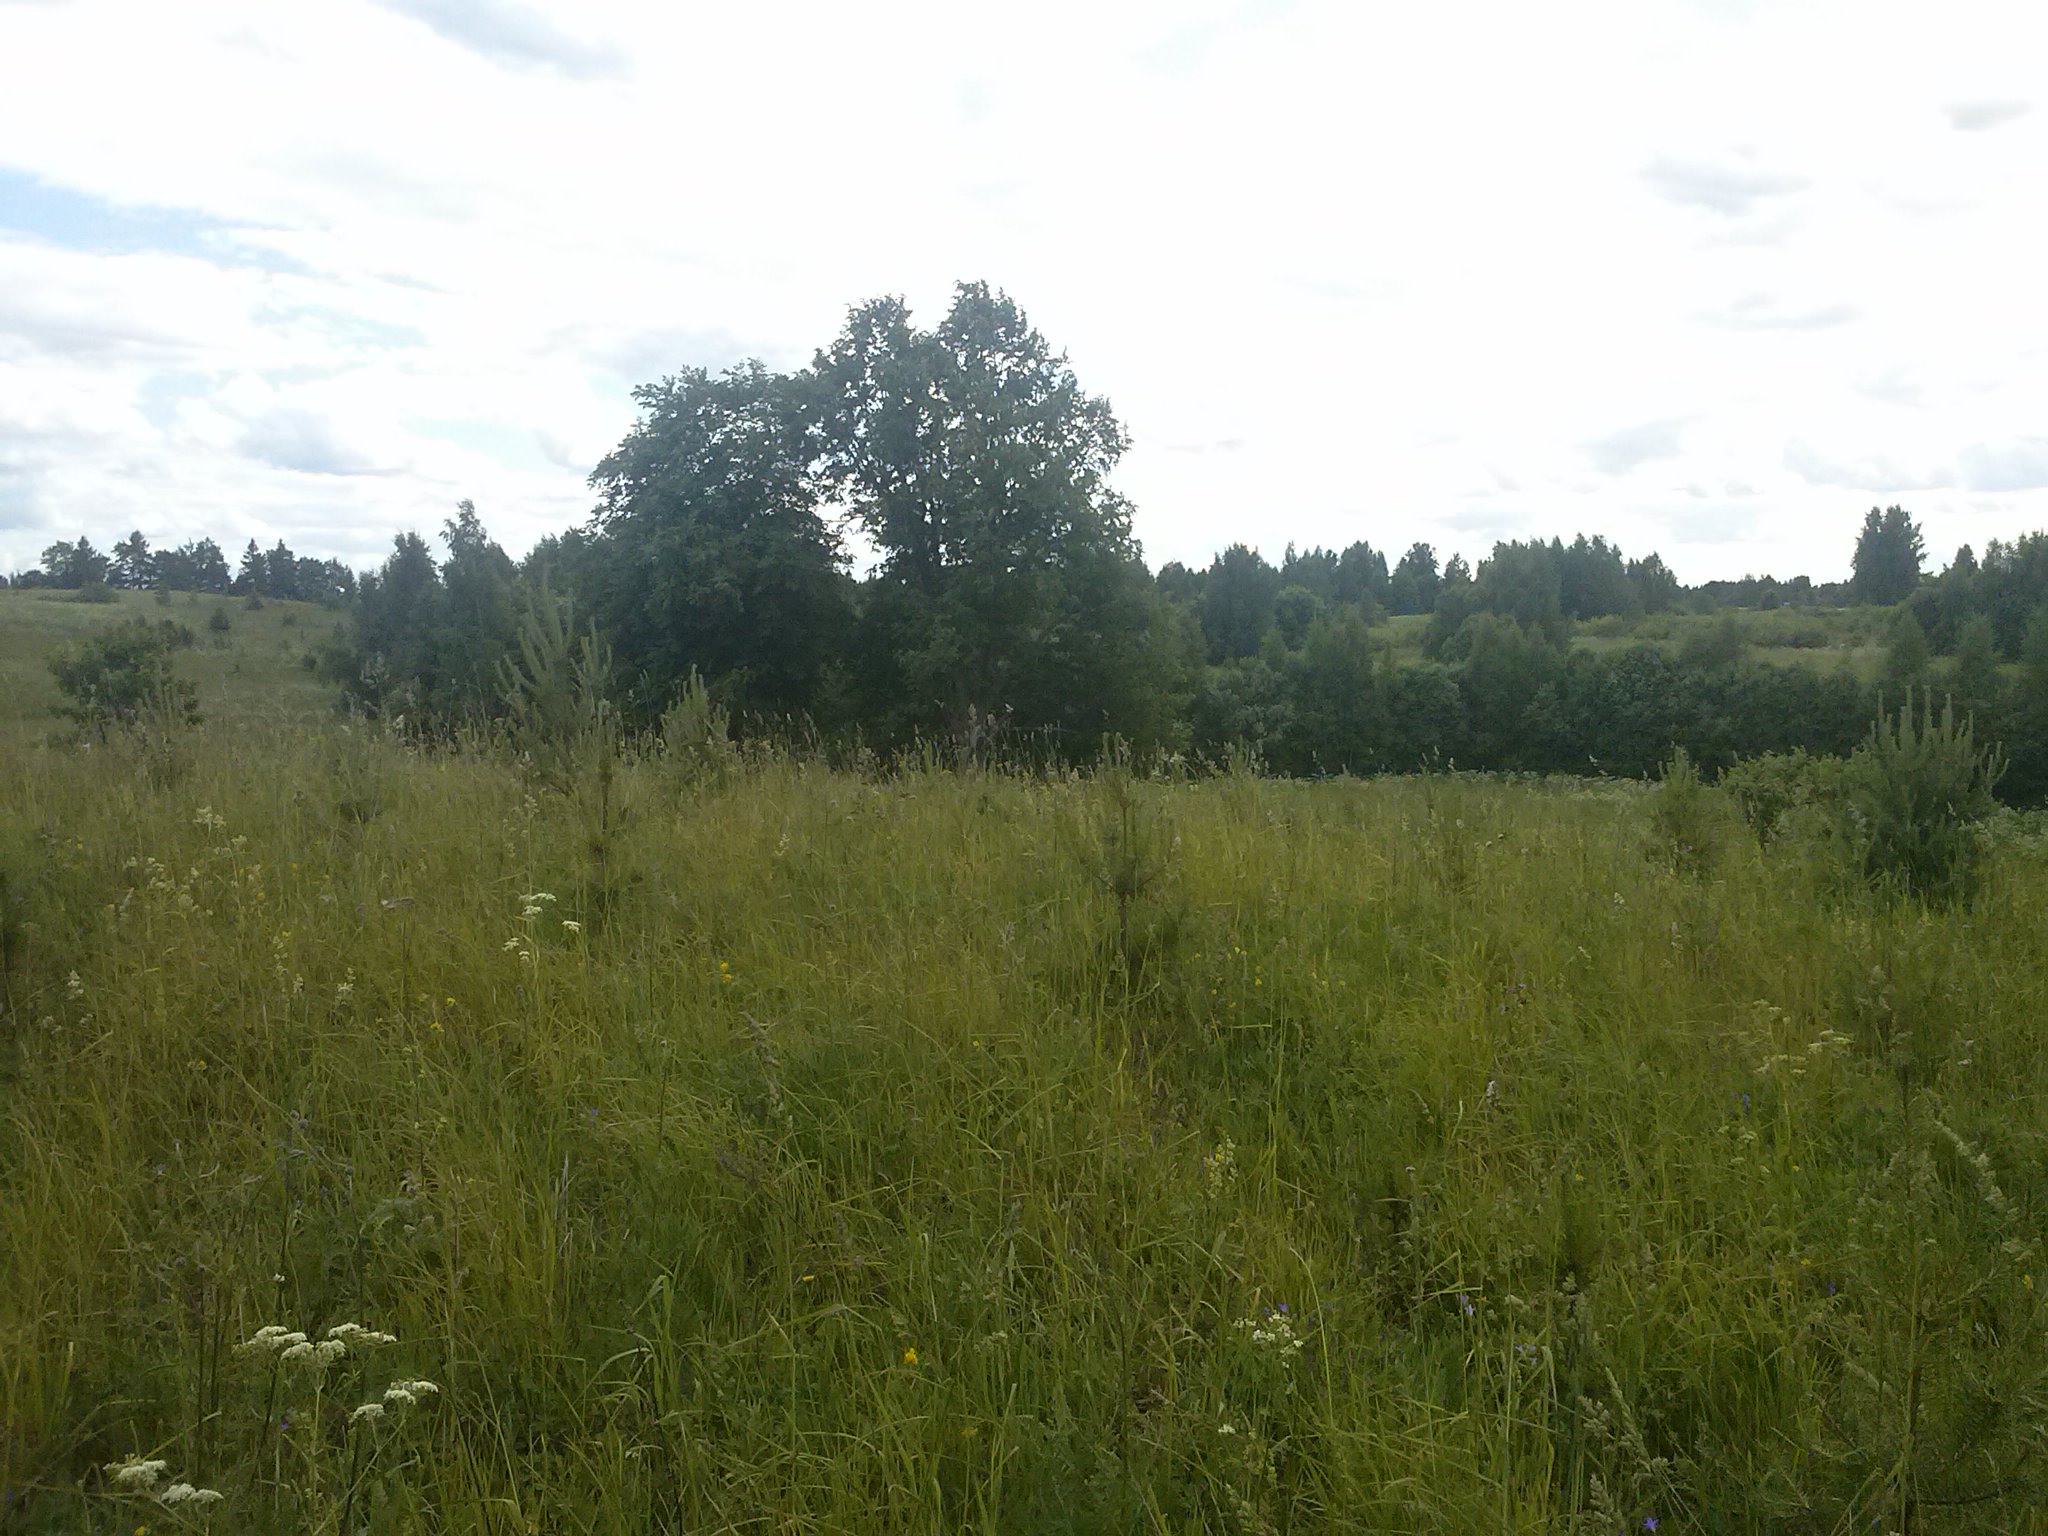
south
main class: Grassland
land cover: Grassland with sparse tree/shrub cover
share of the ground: > 75 %
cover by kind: herbaceous plants 85 %, shrubs 10 %, coniferous forest trees 5 %
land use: Semi-natural and natural areas not in use
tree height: < 5 m
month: June
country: LV
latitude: 56.4696
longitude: 27.8690
